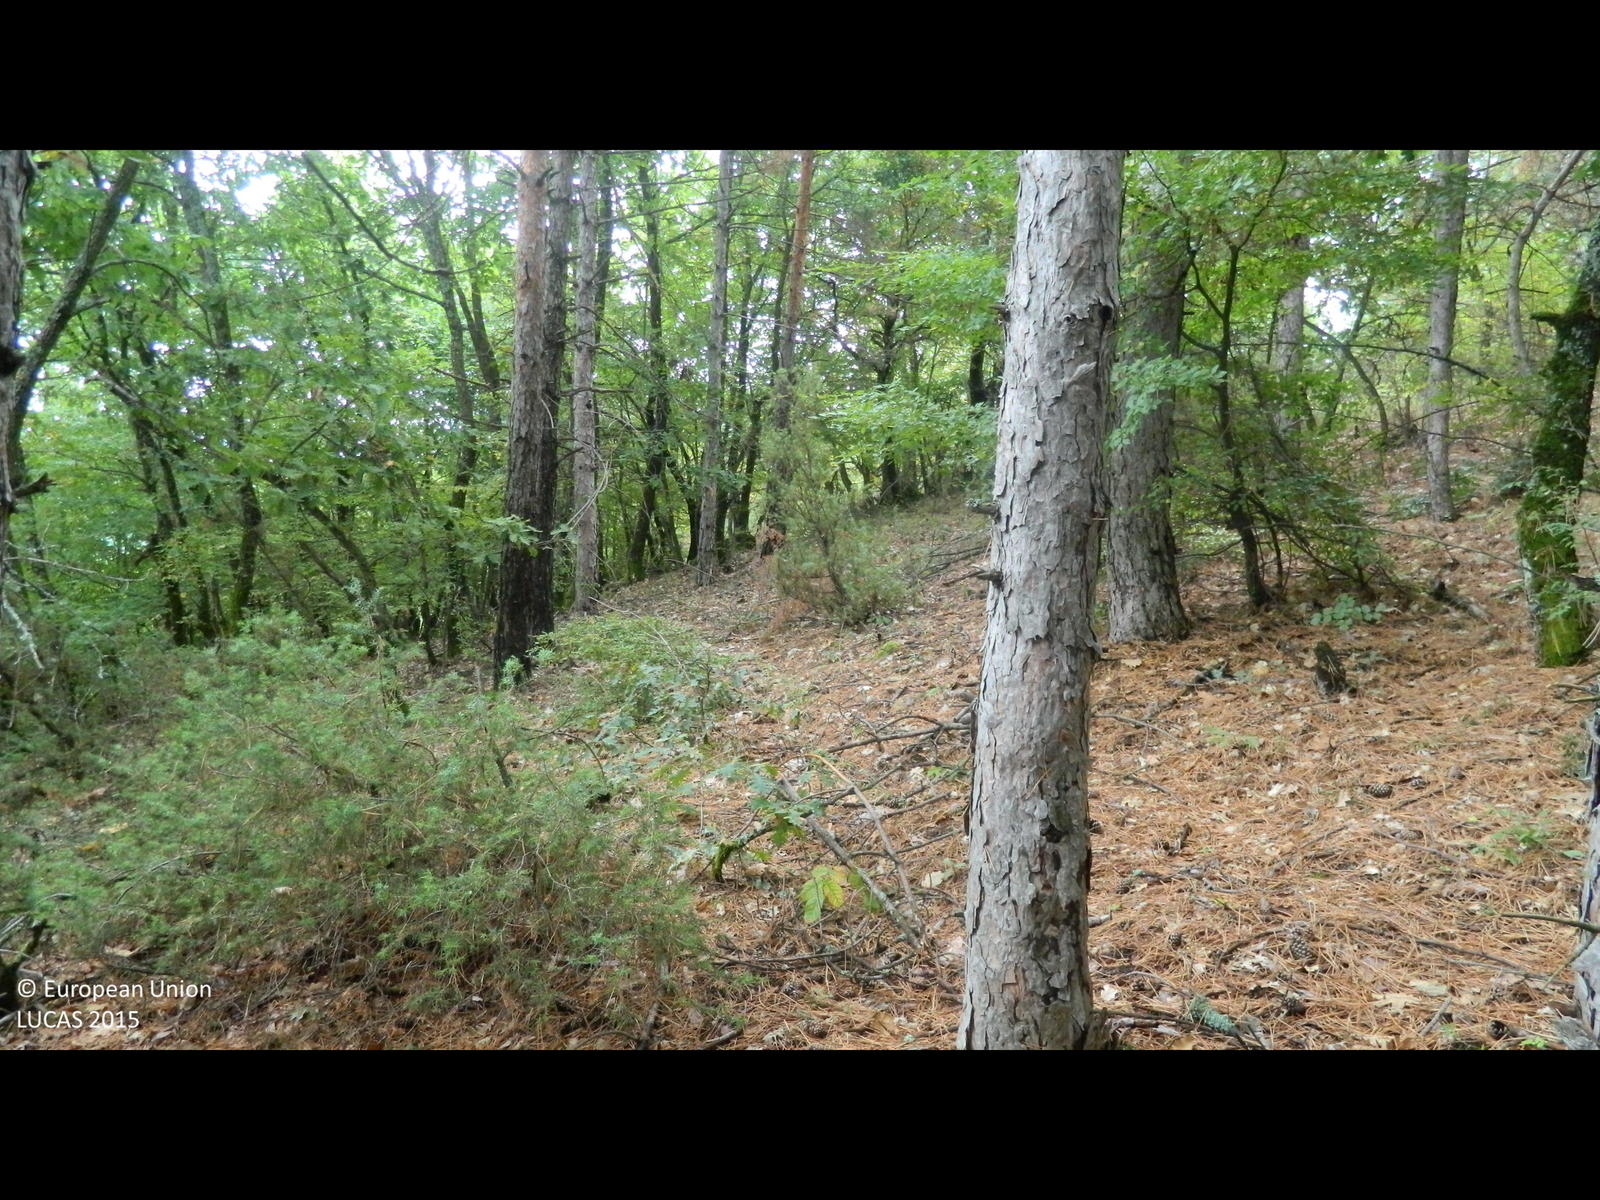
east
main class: Woodland
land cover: Pine dominated mixed woodland
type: hemiboreal forest and nemoral coniferous forest and mixed broadleaved-coniferous forest
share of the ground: > 75 %
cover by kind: coniferous forest trees 65 %, broadleaved forest trees 25 %, shrubs 5 %, unconsolidated bare surface 5 %
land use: Forestry
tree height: > 5 m
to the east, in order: Pine dominated mixed woodland; Broadleaved woodland; Pine dominated mixed woodland; Broadleaved woodland; Tracks; Broadleaved woodland; Pine dominated coniferous woodland; Broadleaved woodland
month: September
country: BG
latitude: 41.6465
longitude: 25.7817
